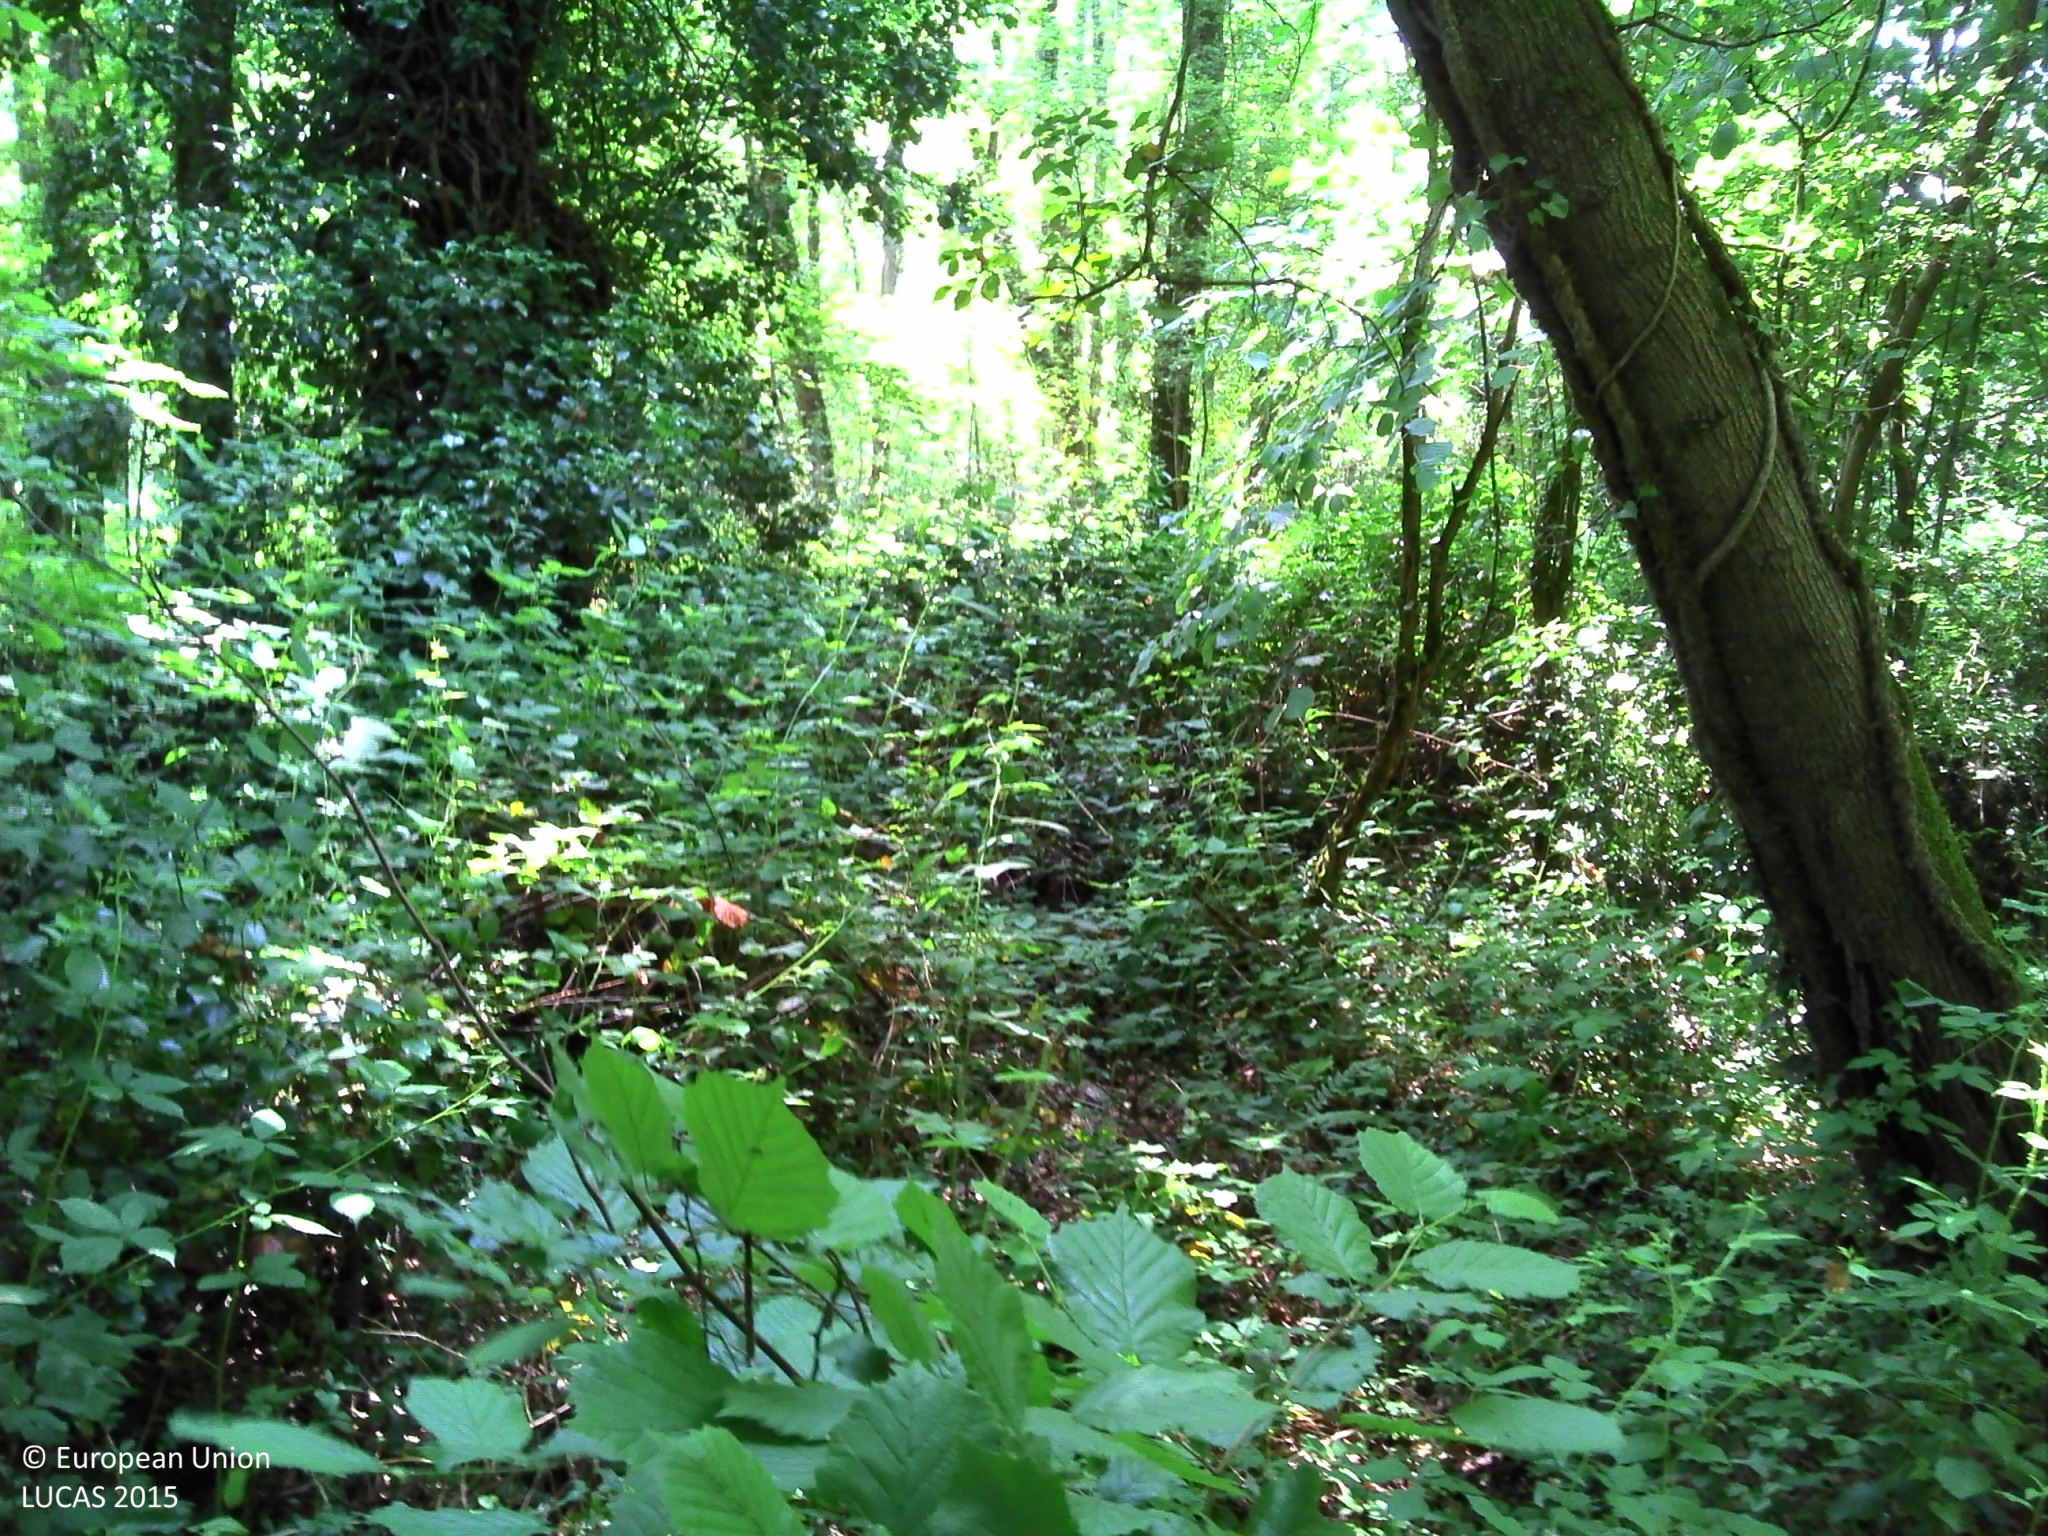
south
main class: Woodland
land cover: Broadleaved woodland
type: mesophytic deciduous forest
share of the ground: > 75 %
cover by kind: broadleaved forest trees 95 %, herbaceous plants 5 %
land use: Semi-natural and natural areas not in use
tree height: > 5 m
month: June
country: FR
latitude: 47.1701
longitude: -1.4526
